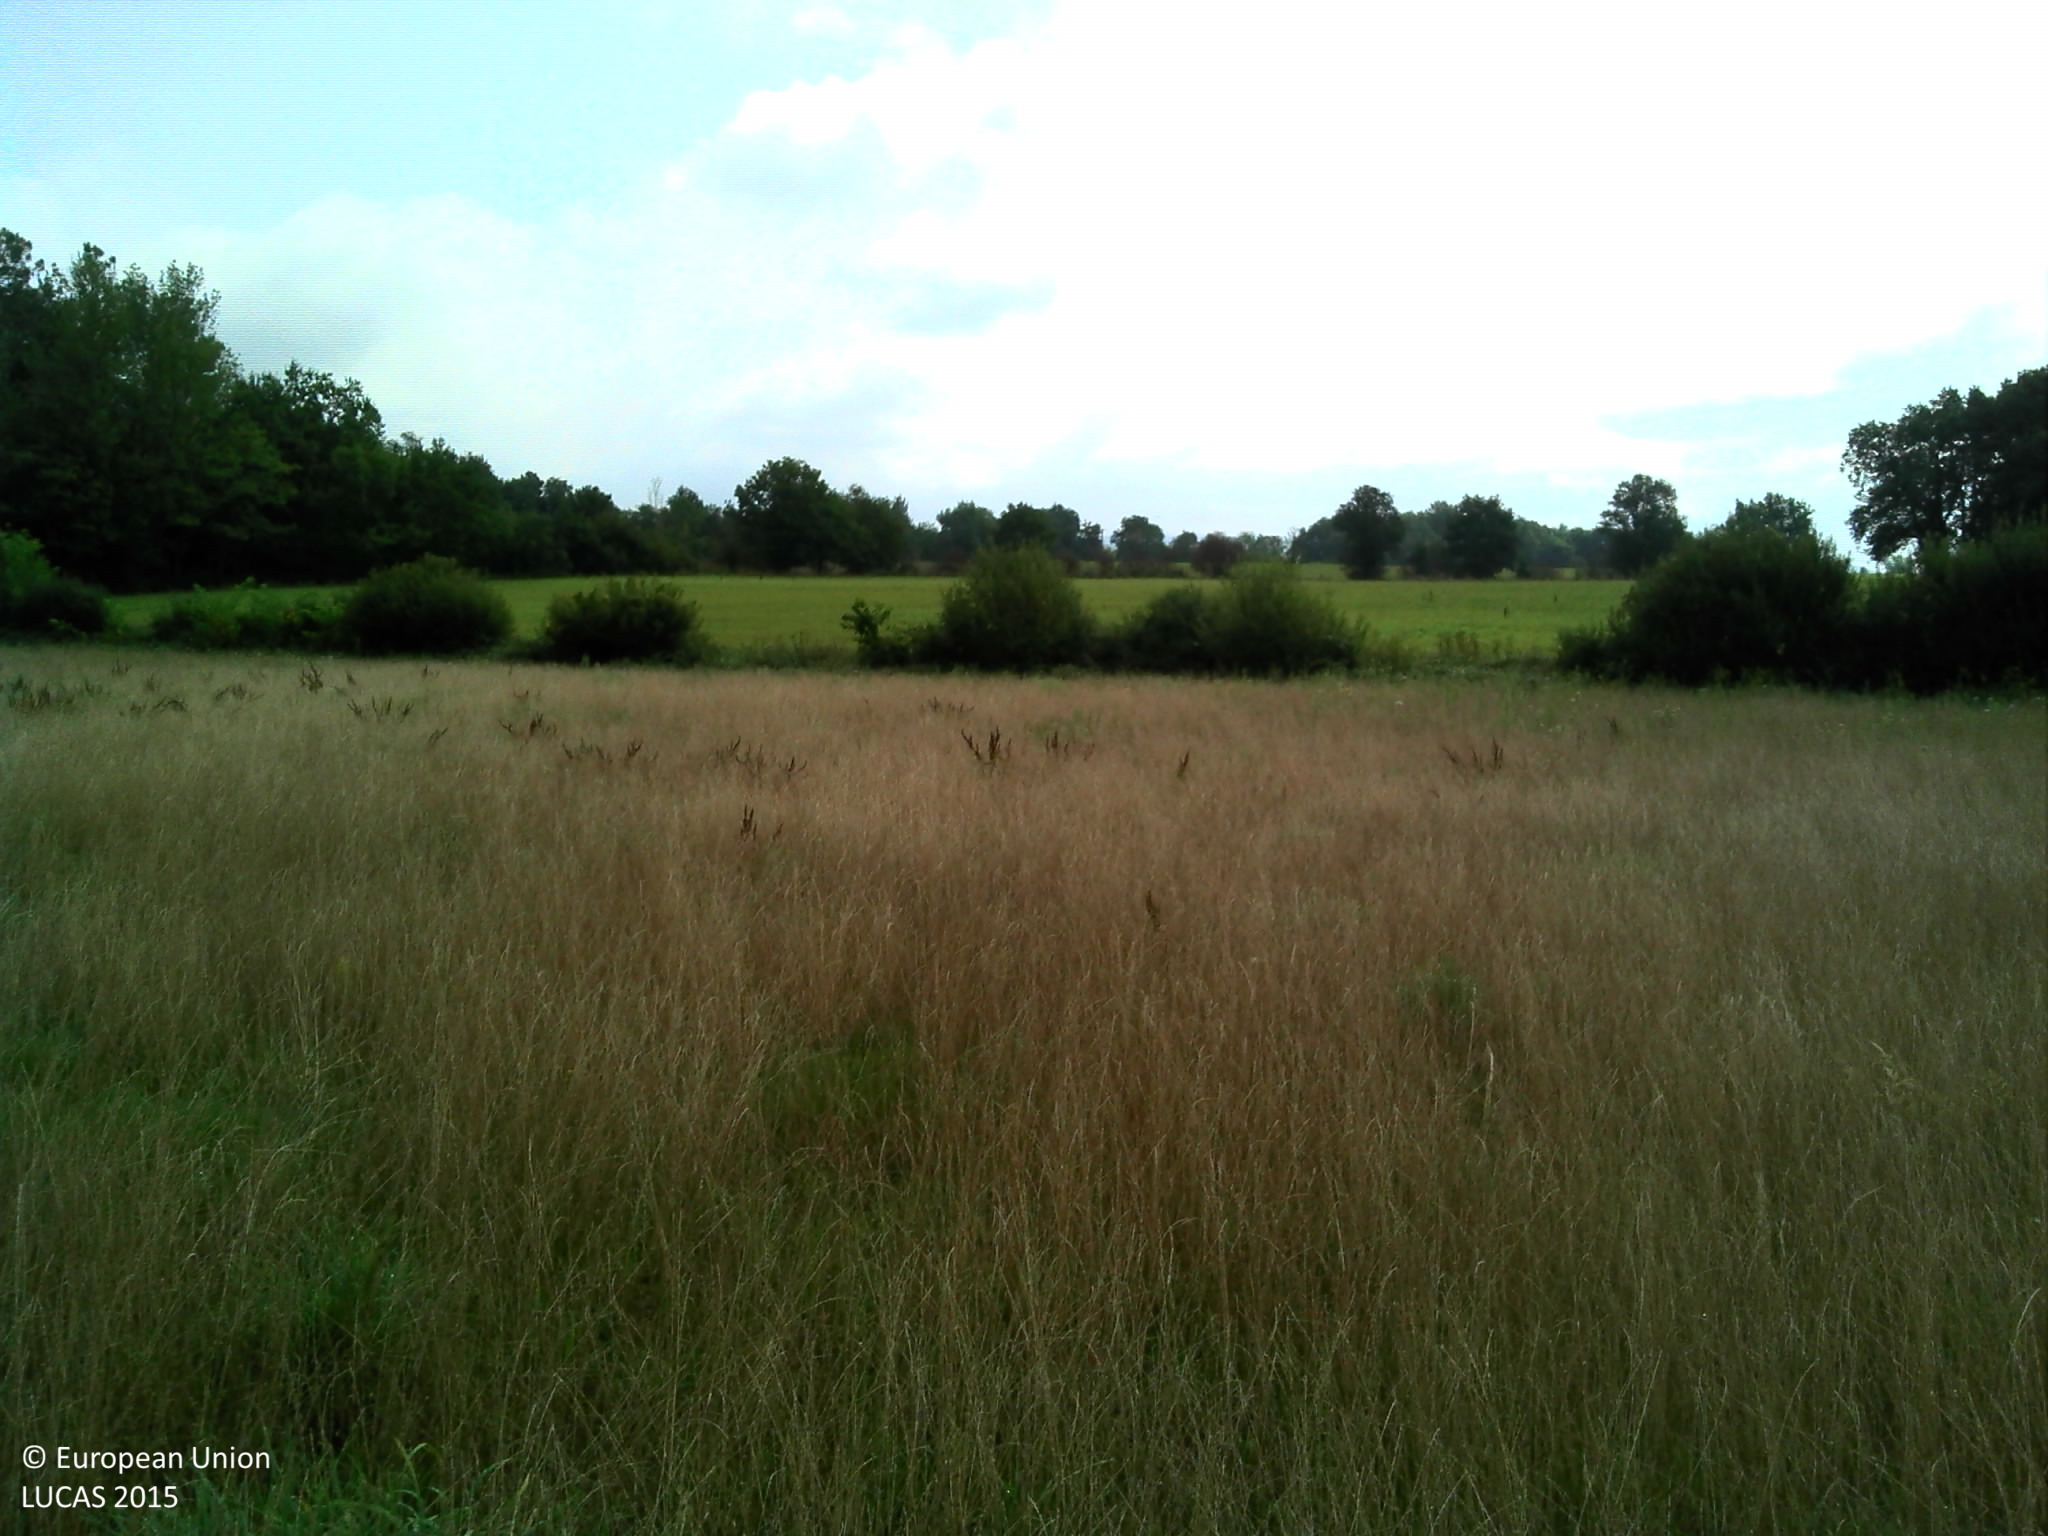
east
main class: Grassland
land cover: Grassland without tree/shrub cover
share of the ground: > 75 %
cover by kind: herbaceous plants 100 %
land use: Agriculture (excluding fallow land and kitchen gardens)
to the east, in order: Grassland without tree/shrub cover; Ditches and canals; Managed hedges; Temporary grasslands; Ditches and canals; Managed hedges; Grassland without tree/shrub cover
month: August
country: FR
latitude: 44.0439
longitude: 1.5768
